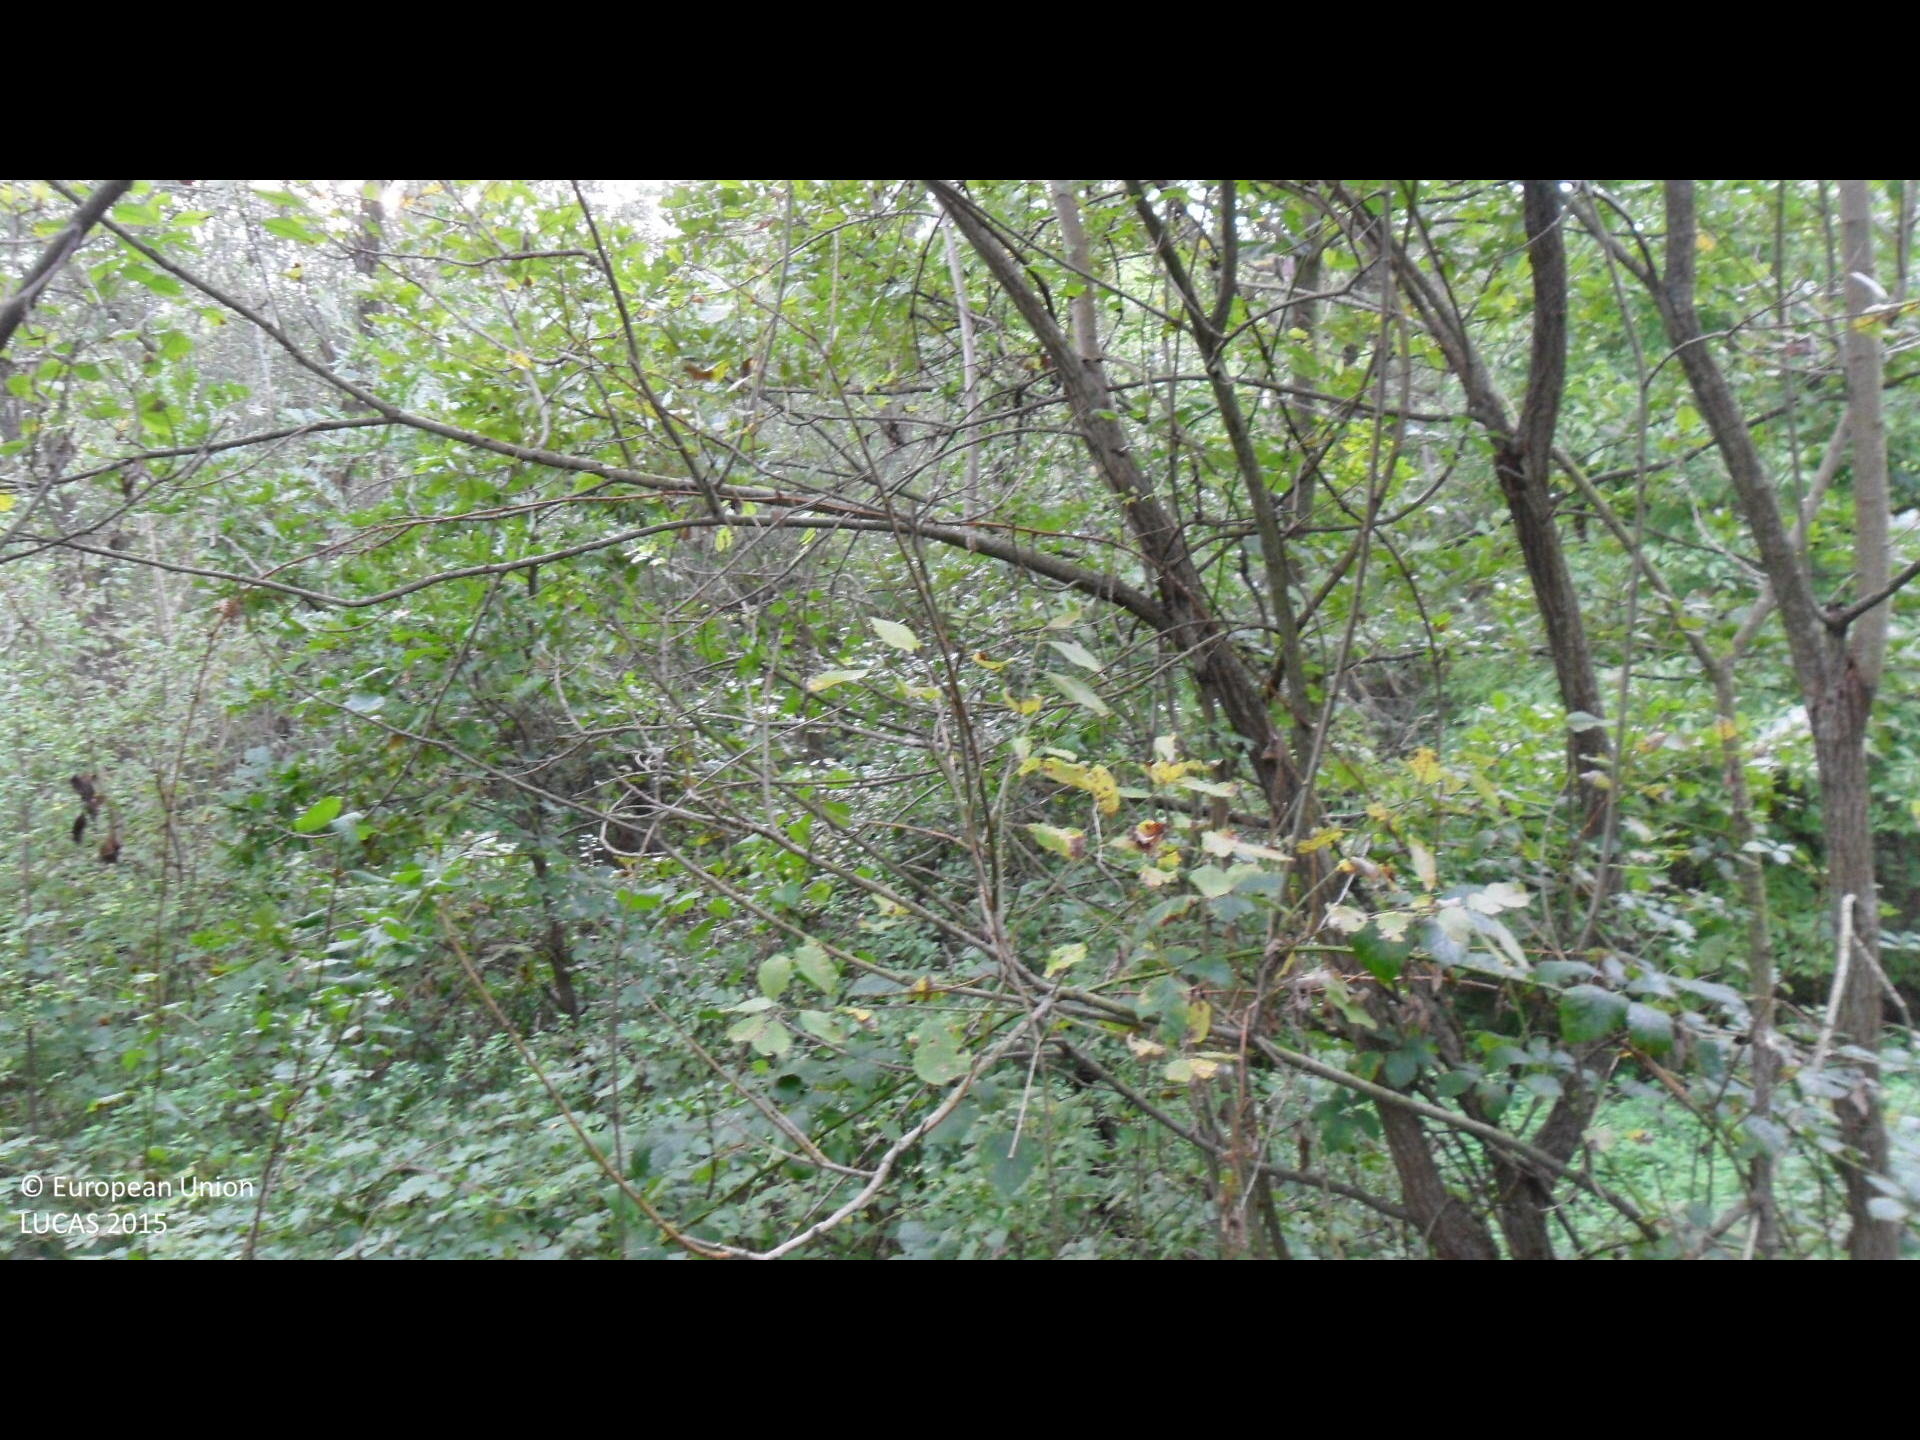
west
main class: Woodland
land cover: Broadleaved woodland
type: mesophytic deciduous forest
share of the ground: > 75 %
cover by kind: broadleaved forest trees 90 %, shrubs 5 %, unconsolidated bare surface 5 %
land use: Semi-natural and natural areas not in use
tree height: < 5 m
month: October
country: BG
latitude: 43.1467
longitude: 26.1633
